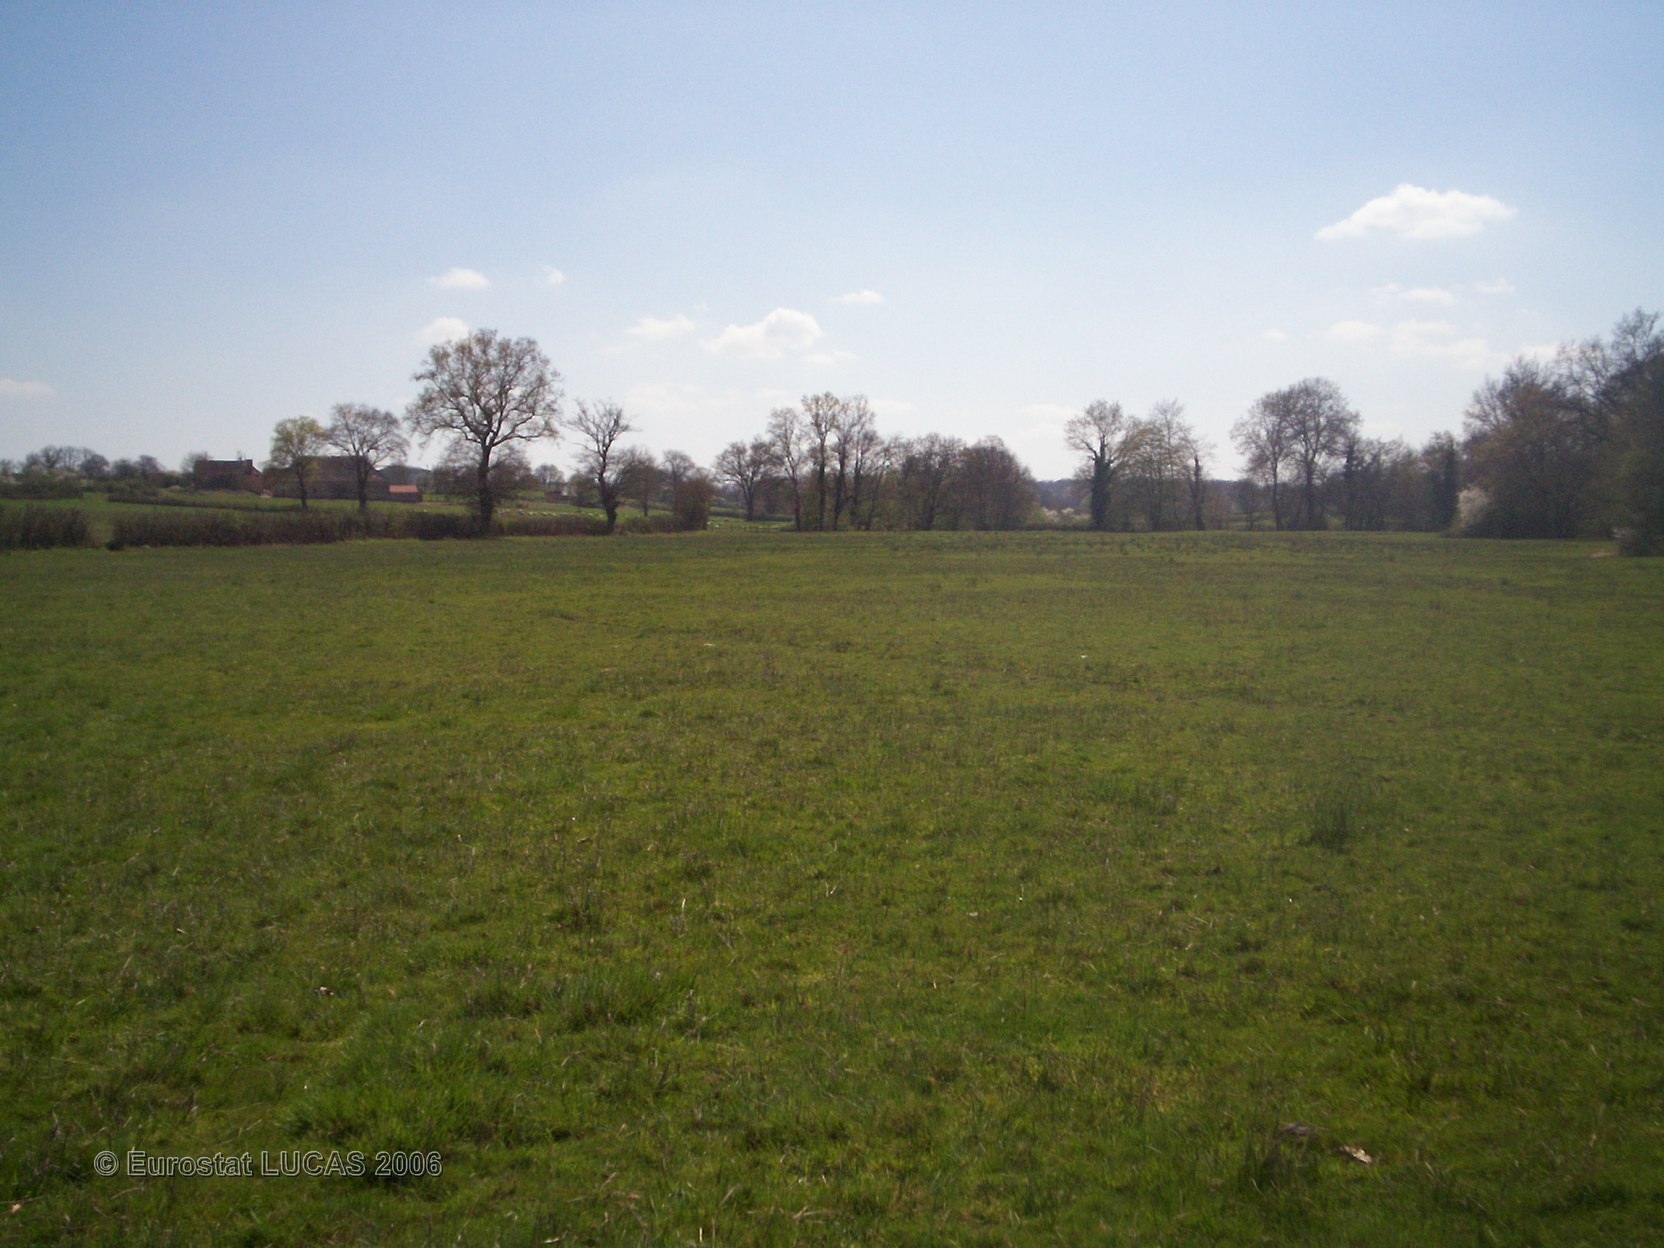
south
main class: Grassland
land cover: Grassland without tree/shrub cover
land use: Agriculture (excluding fallow land and kitchen gardens)
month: April
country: FR
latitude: 46.6548
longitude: 3.1368
